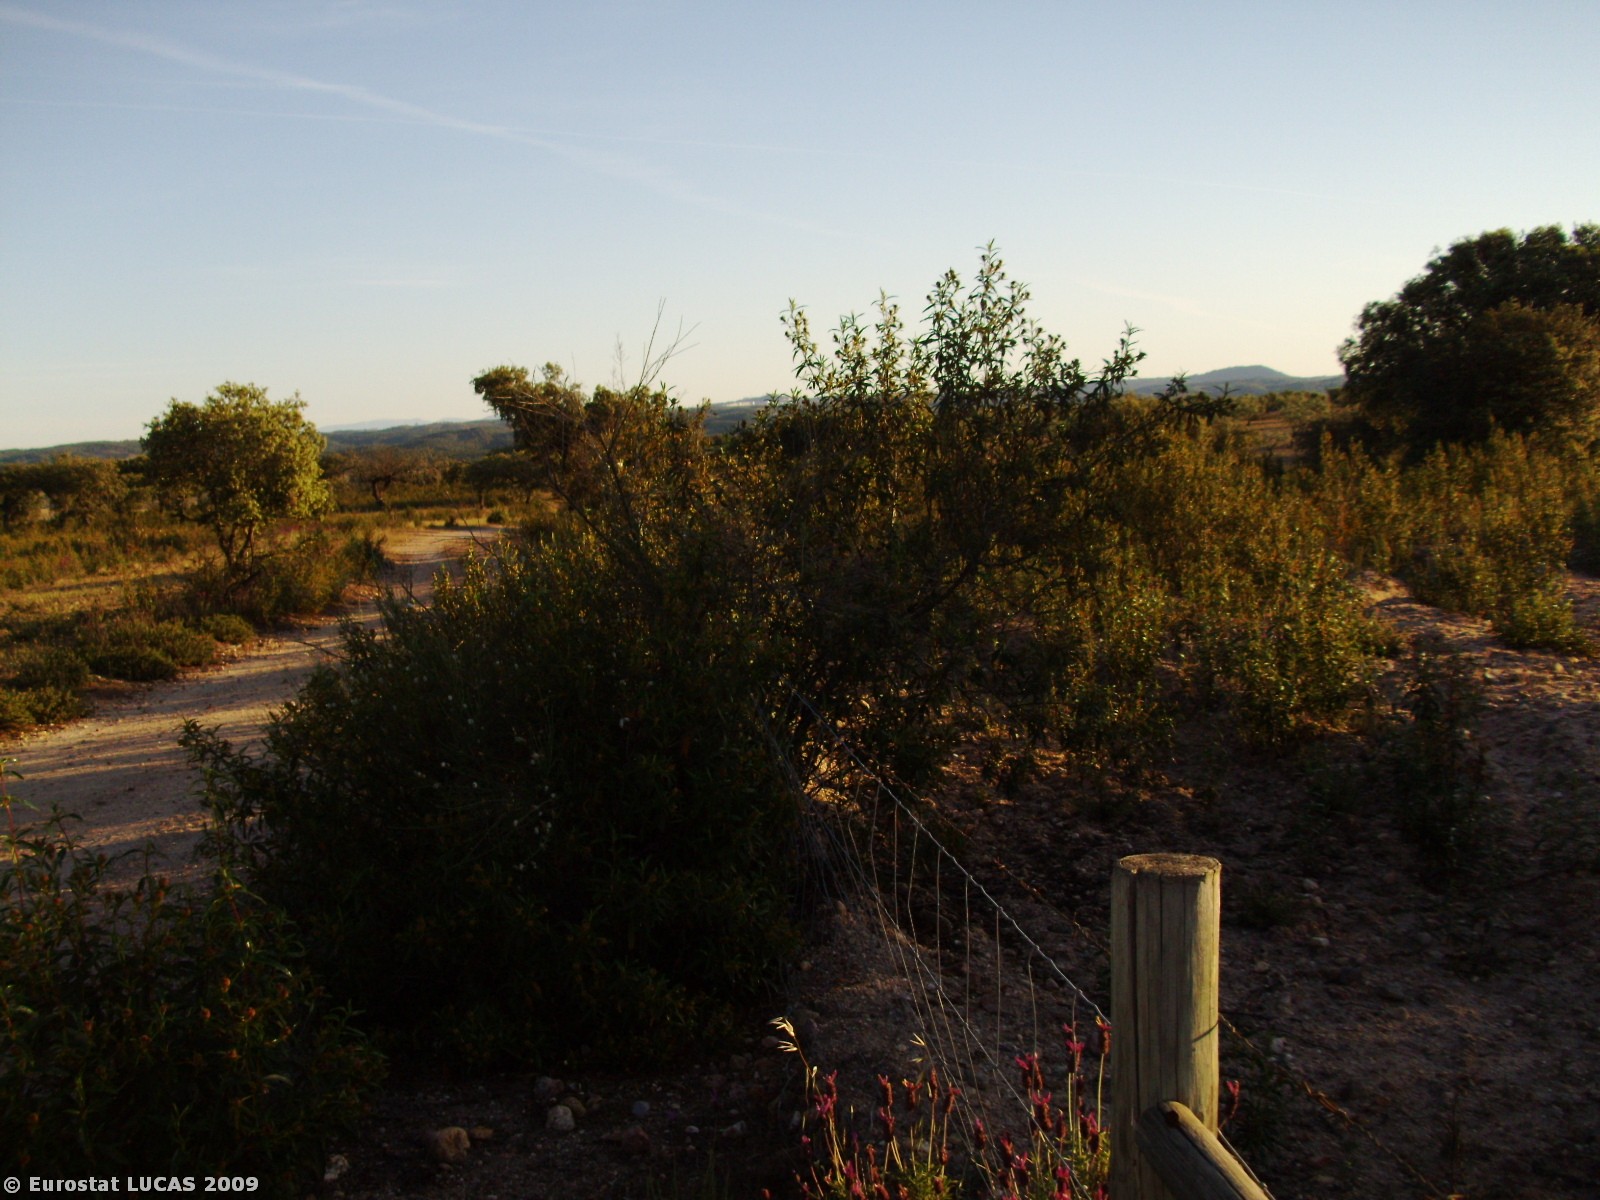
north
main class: Woodland
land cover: Broadleaved woodland
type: broadleaved evergreen forest
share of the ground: 10 - 25 %
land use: Forestry
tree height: > 5 m
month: May
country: PT
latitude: 39.7121
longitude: -7.5125
